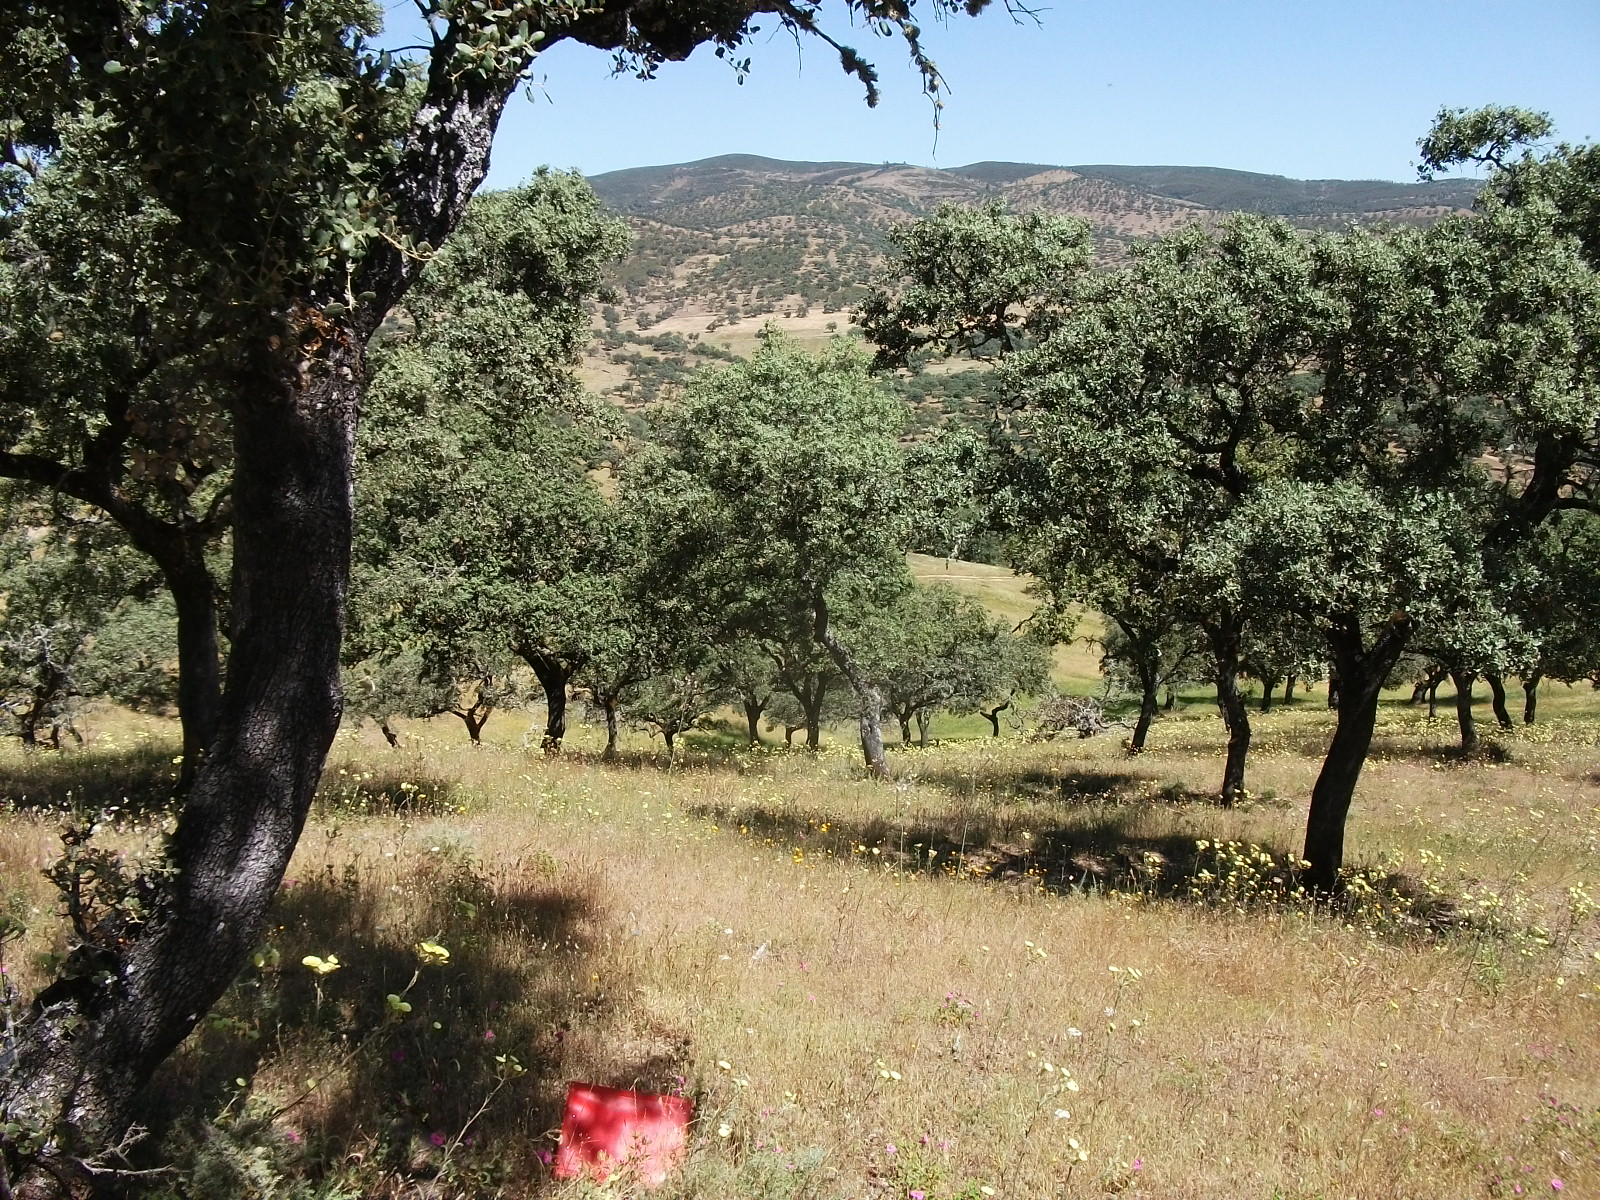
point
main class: Woodland
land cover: Broadleaved woodland
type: broadleaved evergreen forest
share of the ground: 25 - 50 %
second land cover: Spontaneously vegetated surfaces
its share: 50 - 75 %
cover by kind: herbaceous plants 60 %, broadleaved forest trees 40 %
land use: Forestry
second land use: Agriculture (excluding fallow land and kitchen gardens)
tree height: > 5 m
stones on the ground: 25 - 50 %
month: May
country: ES
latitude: 37.9562
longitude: -6.6050
